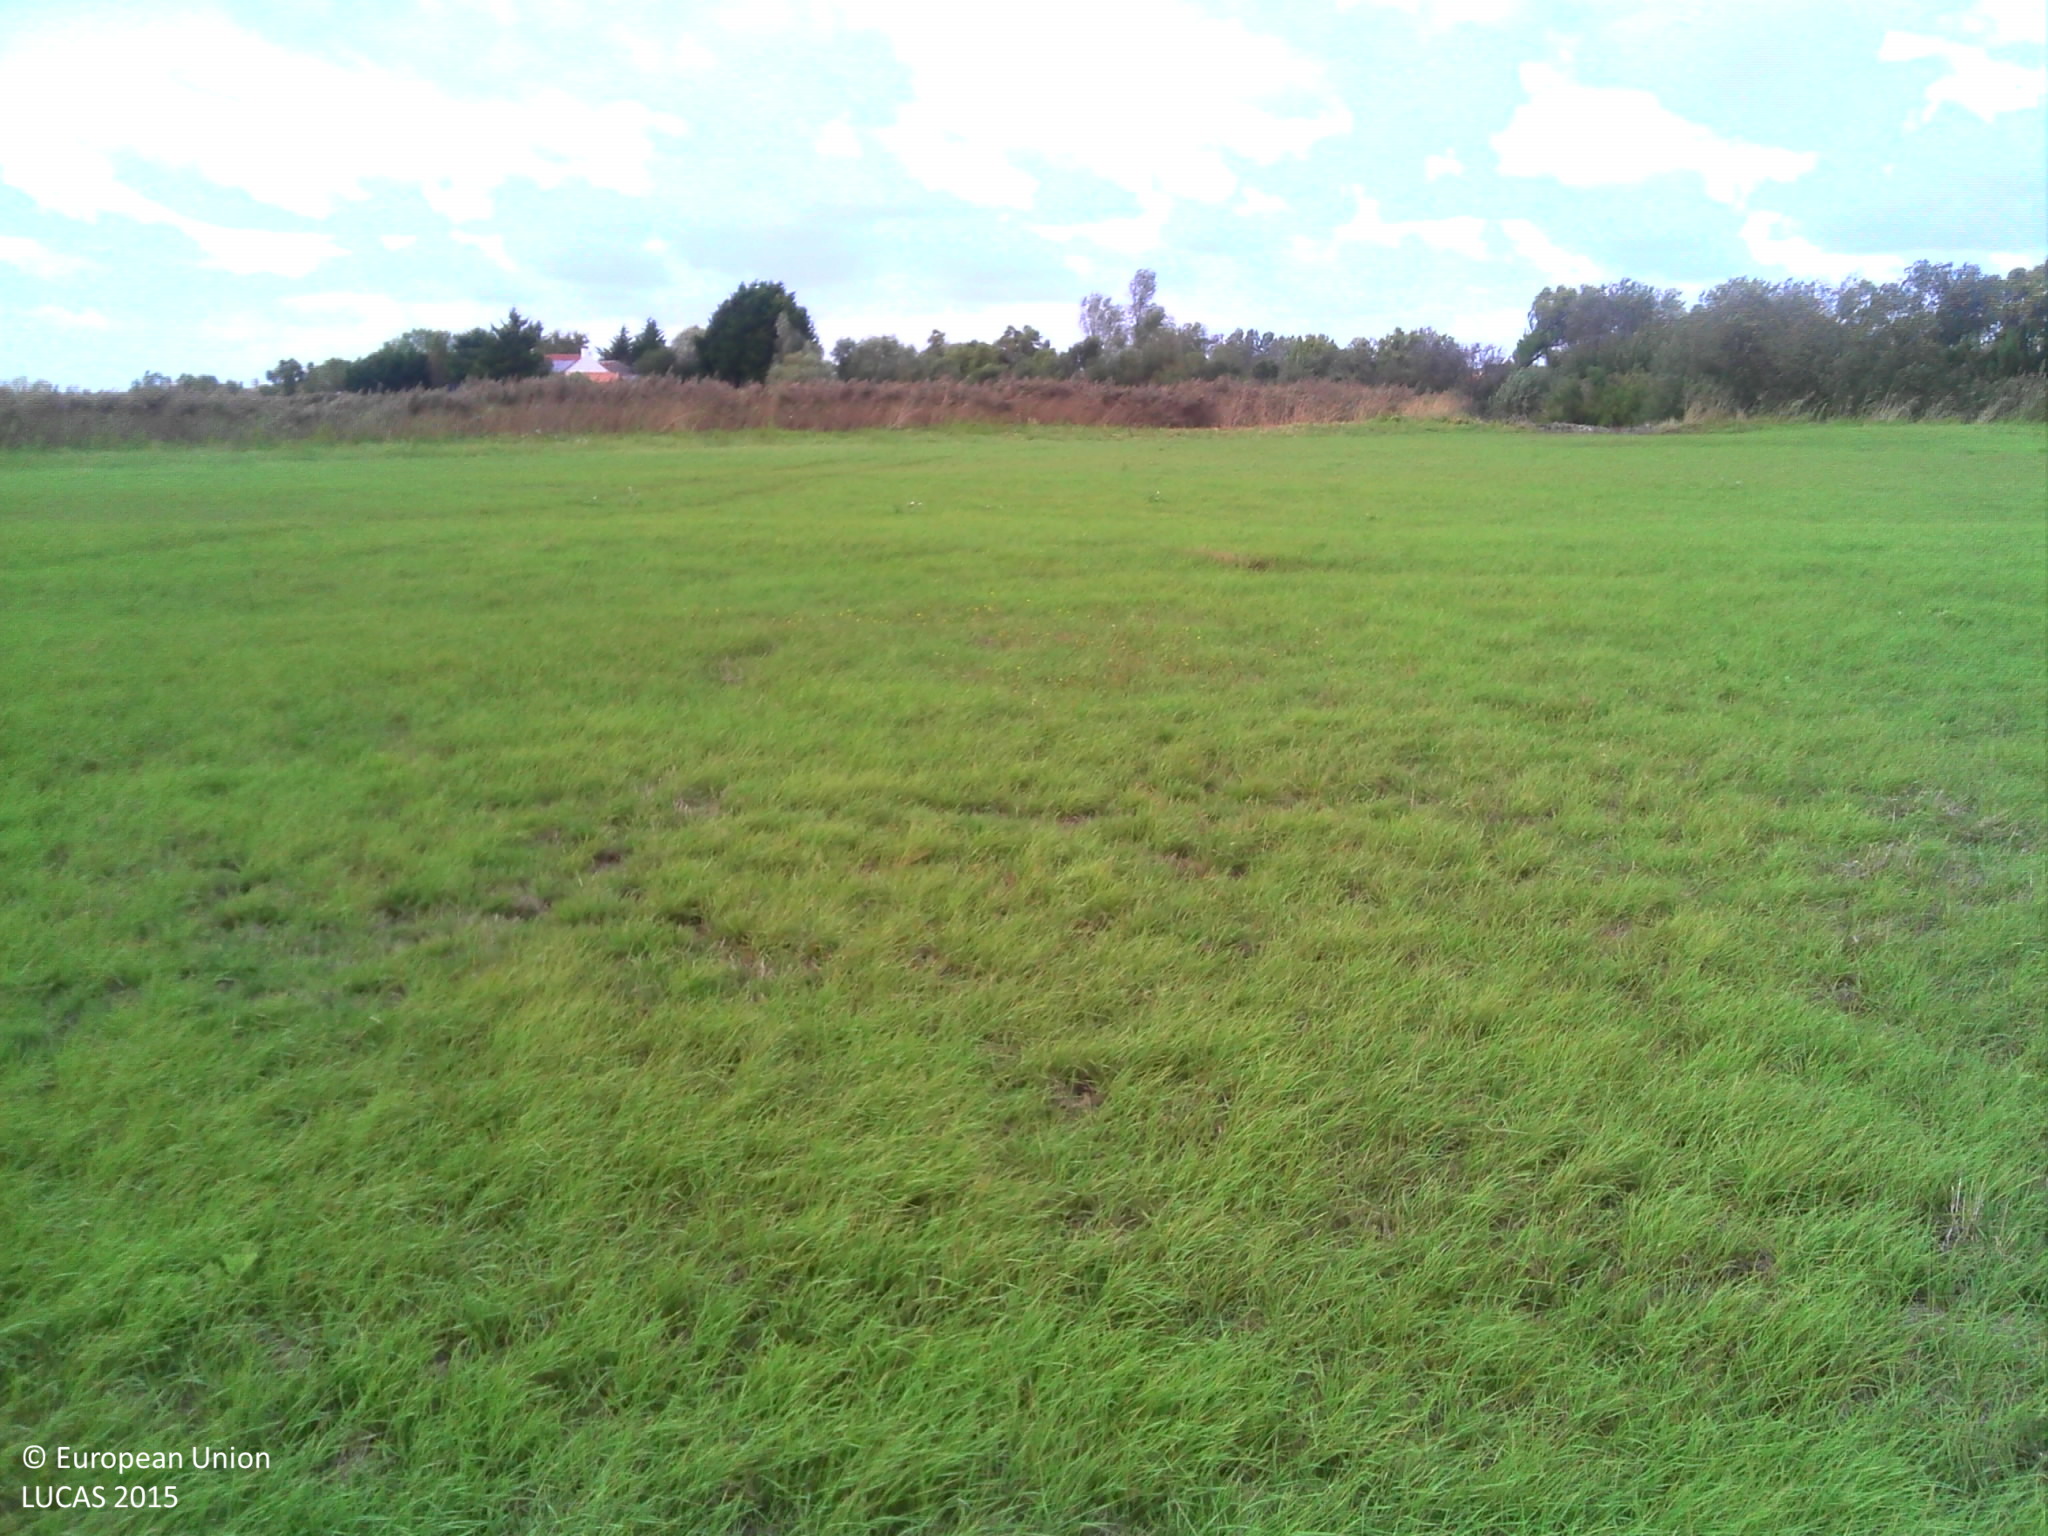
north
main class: Grassland
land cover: Grassland without tree/shrub cover
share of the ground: > 75 %
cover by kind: herbaceous plants 100 %
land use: Agriculture (excluding fallow land and kitchen gardens)
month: September
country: FR
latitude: 46.7557
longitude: -1.9188
